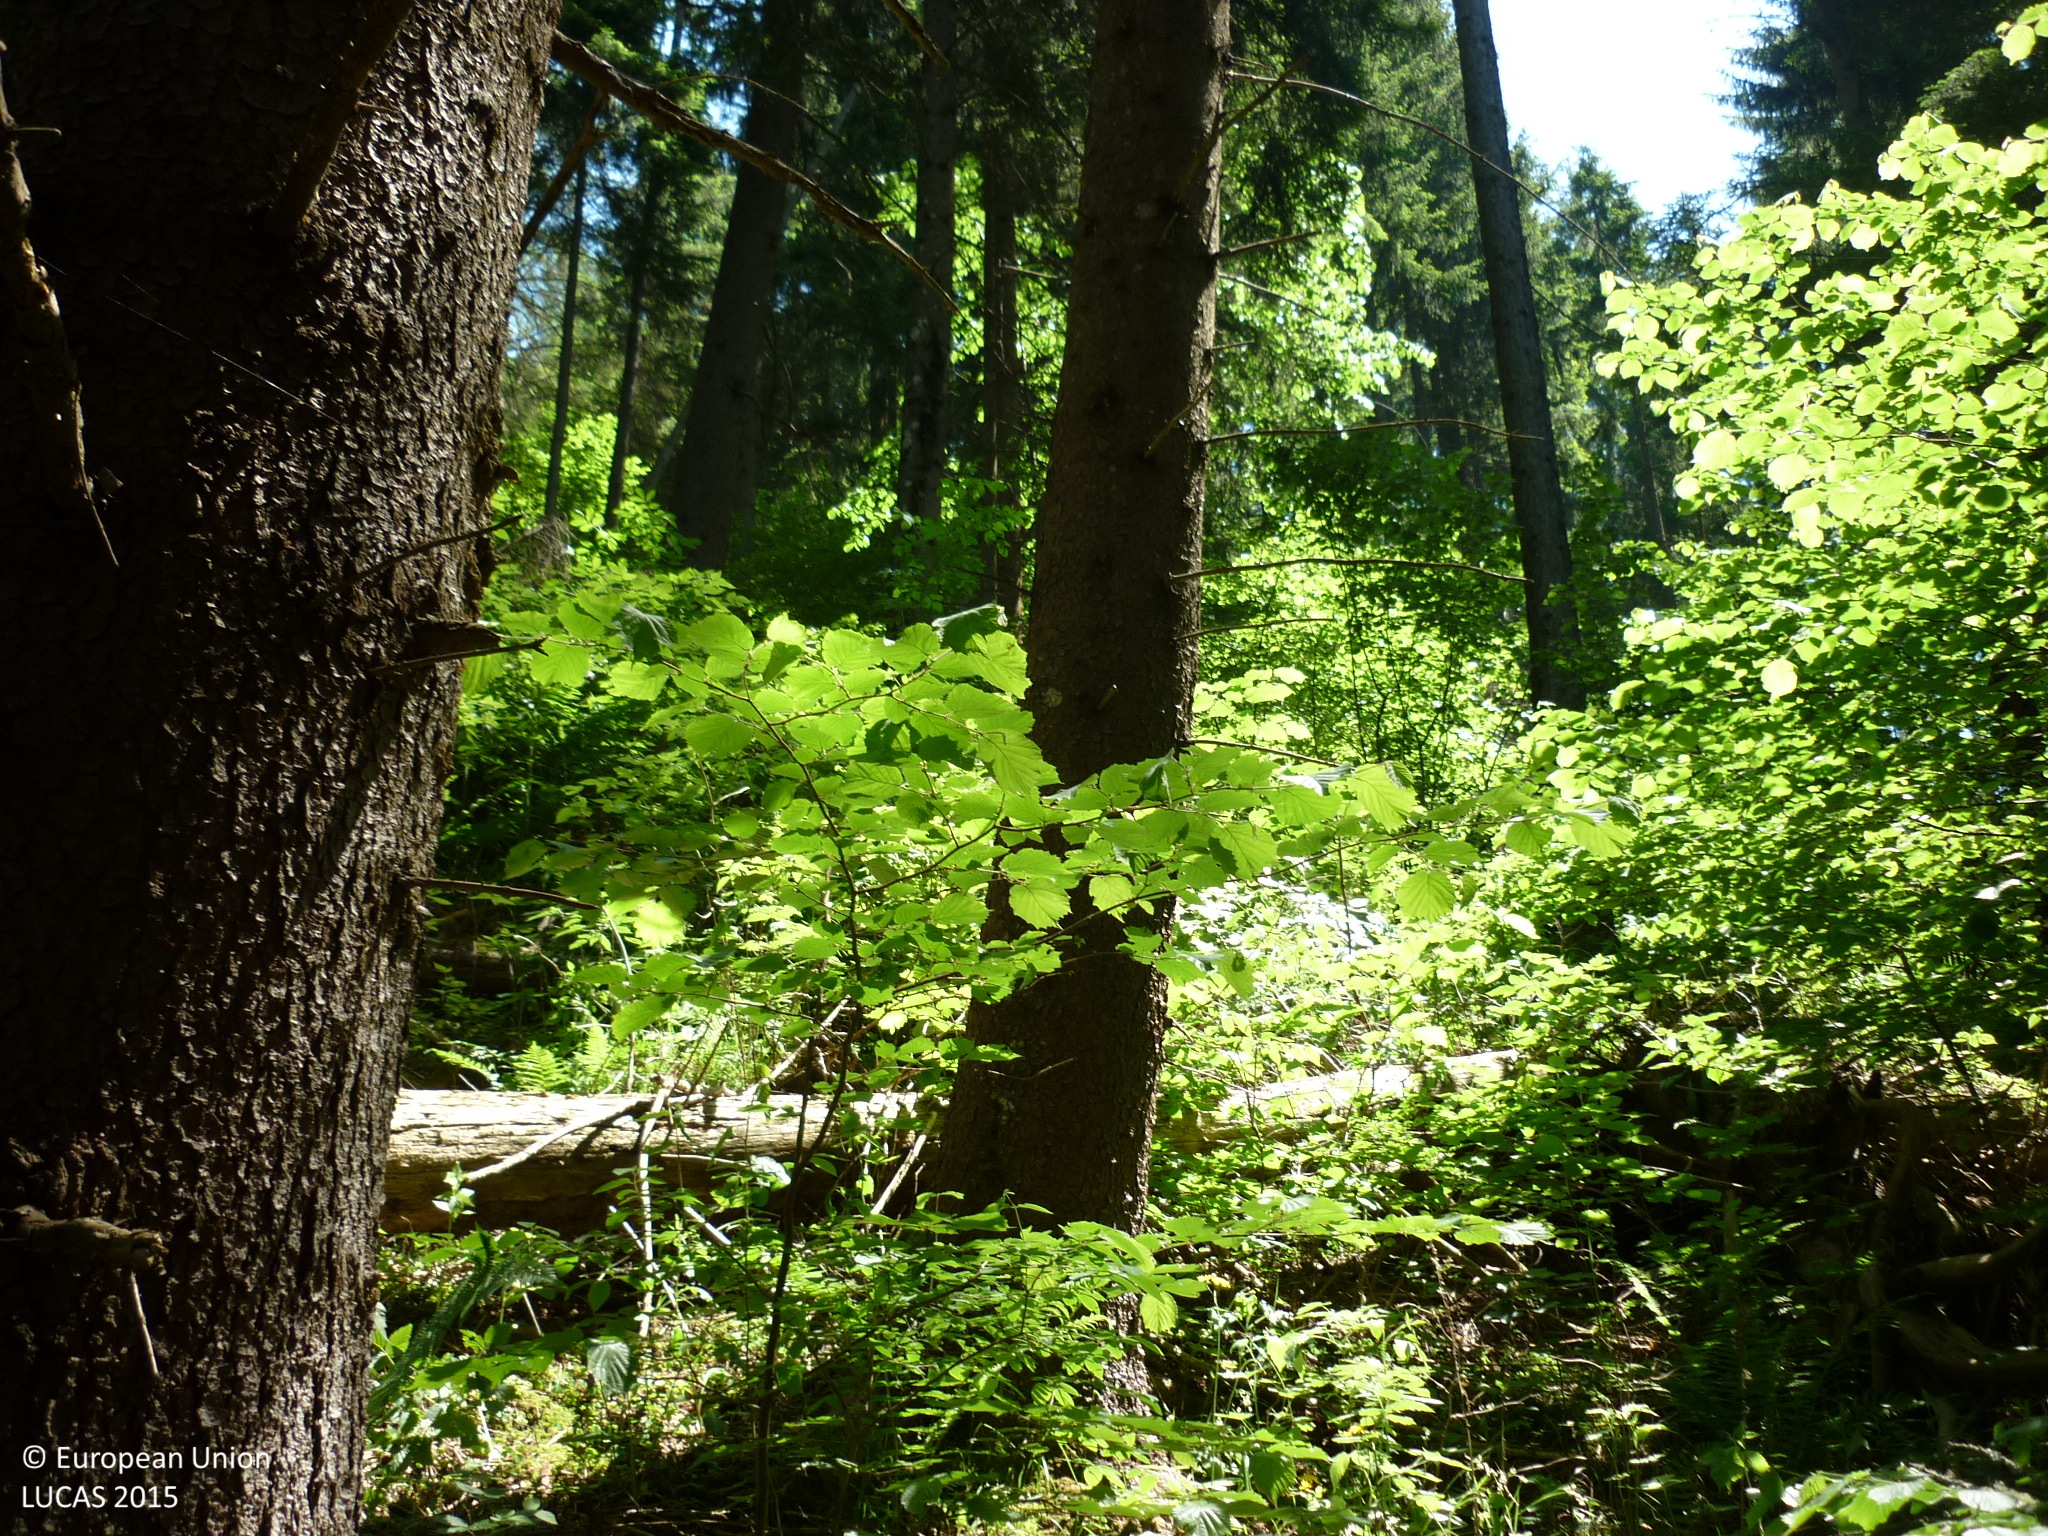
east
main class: Woodland
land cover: Spruce dominated coniferous woodland
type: alpine coniferous forest
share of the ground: > 75 %
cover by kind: coniferous forest trees 75 %, broadleaved forest trees 10 %, shrubs 10 %, herbaceous plants 5 %
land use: Forestry
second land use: Amenities, museums, leisure
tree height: > 5 m
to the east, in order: Spruce dominated coniferous woodland; Shrubland without tree cover; Tracks; Spruce dominated coniferous woodland
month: June
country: AT
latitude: 47.1172
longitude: 14.1762
